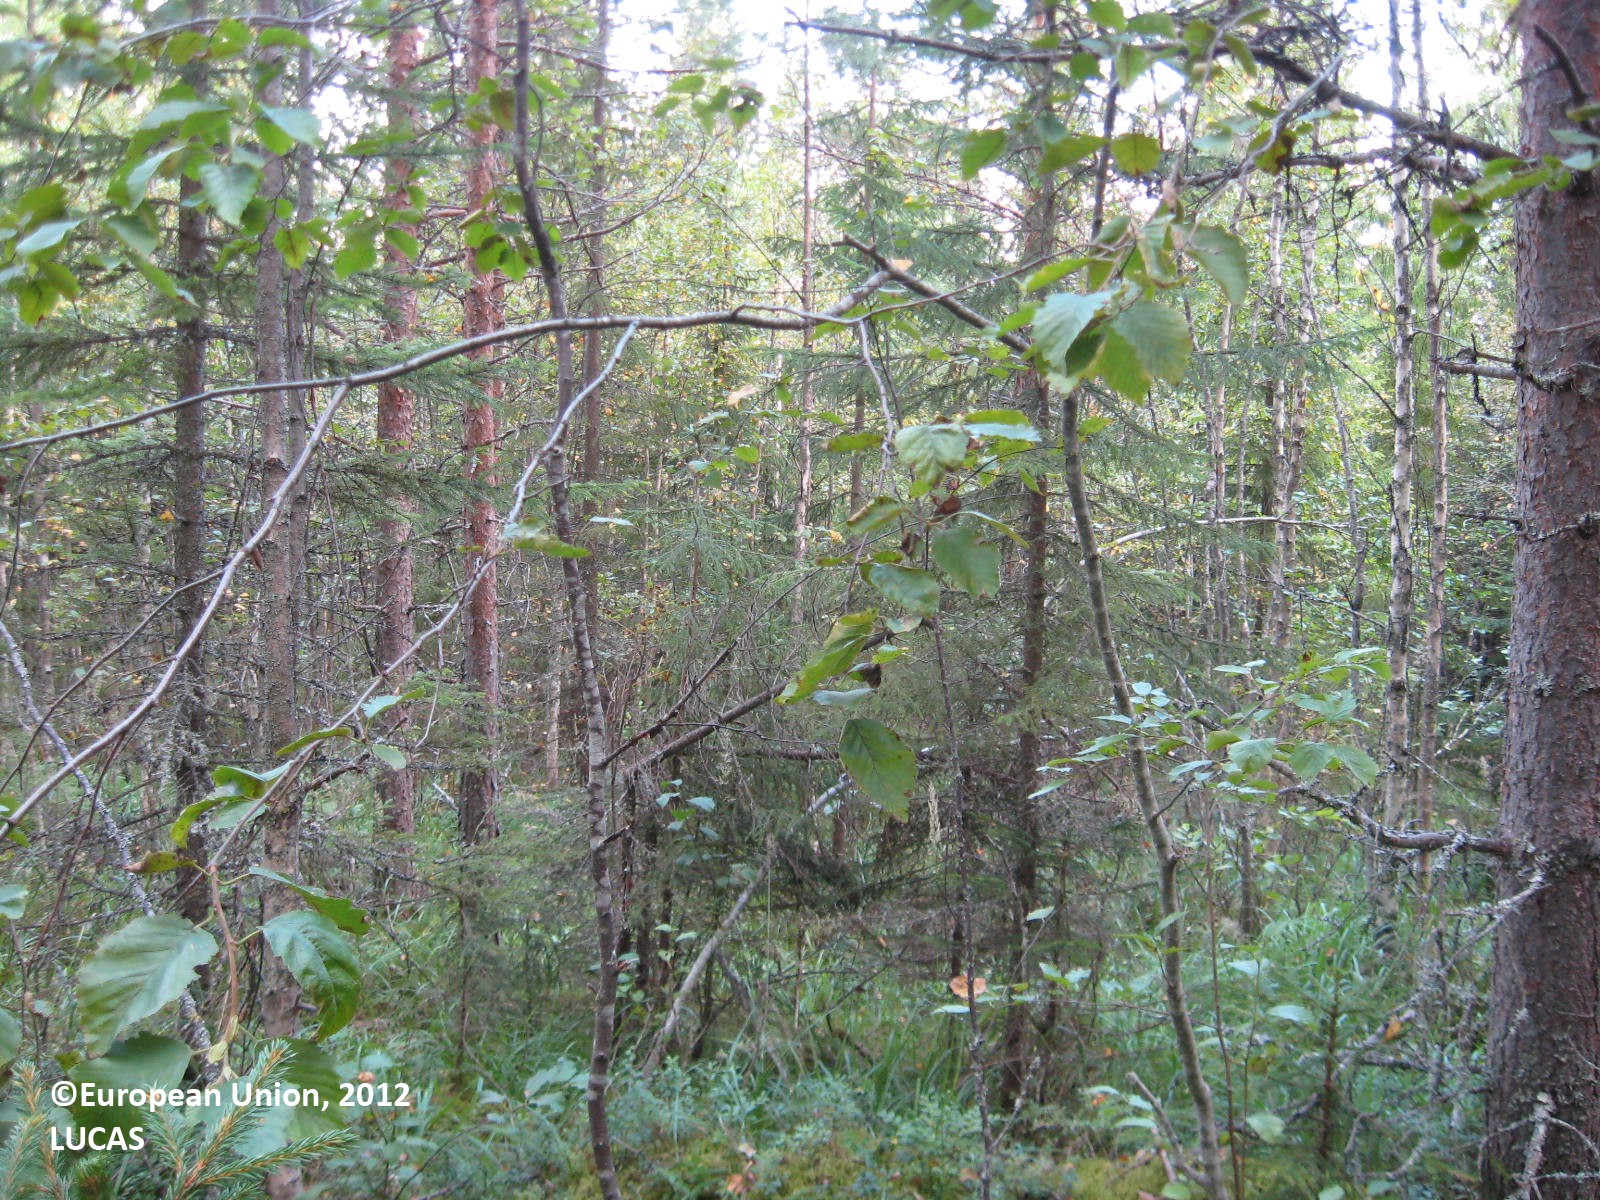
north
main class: Woodland
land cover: Other mixed woodland
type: boreal forest
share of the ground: > 75 %
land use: Forestry
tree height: > 5 m
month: August
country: FI
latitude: 63.4798
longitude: 30.3994
